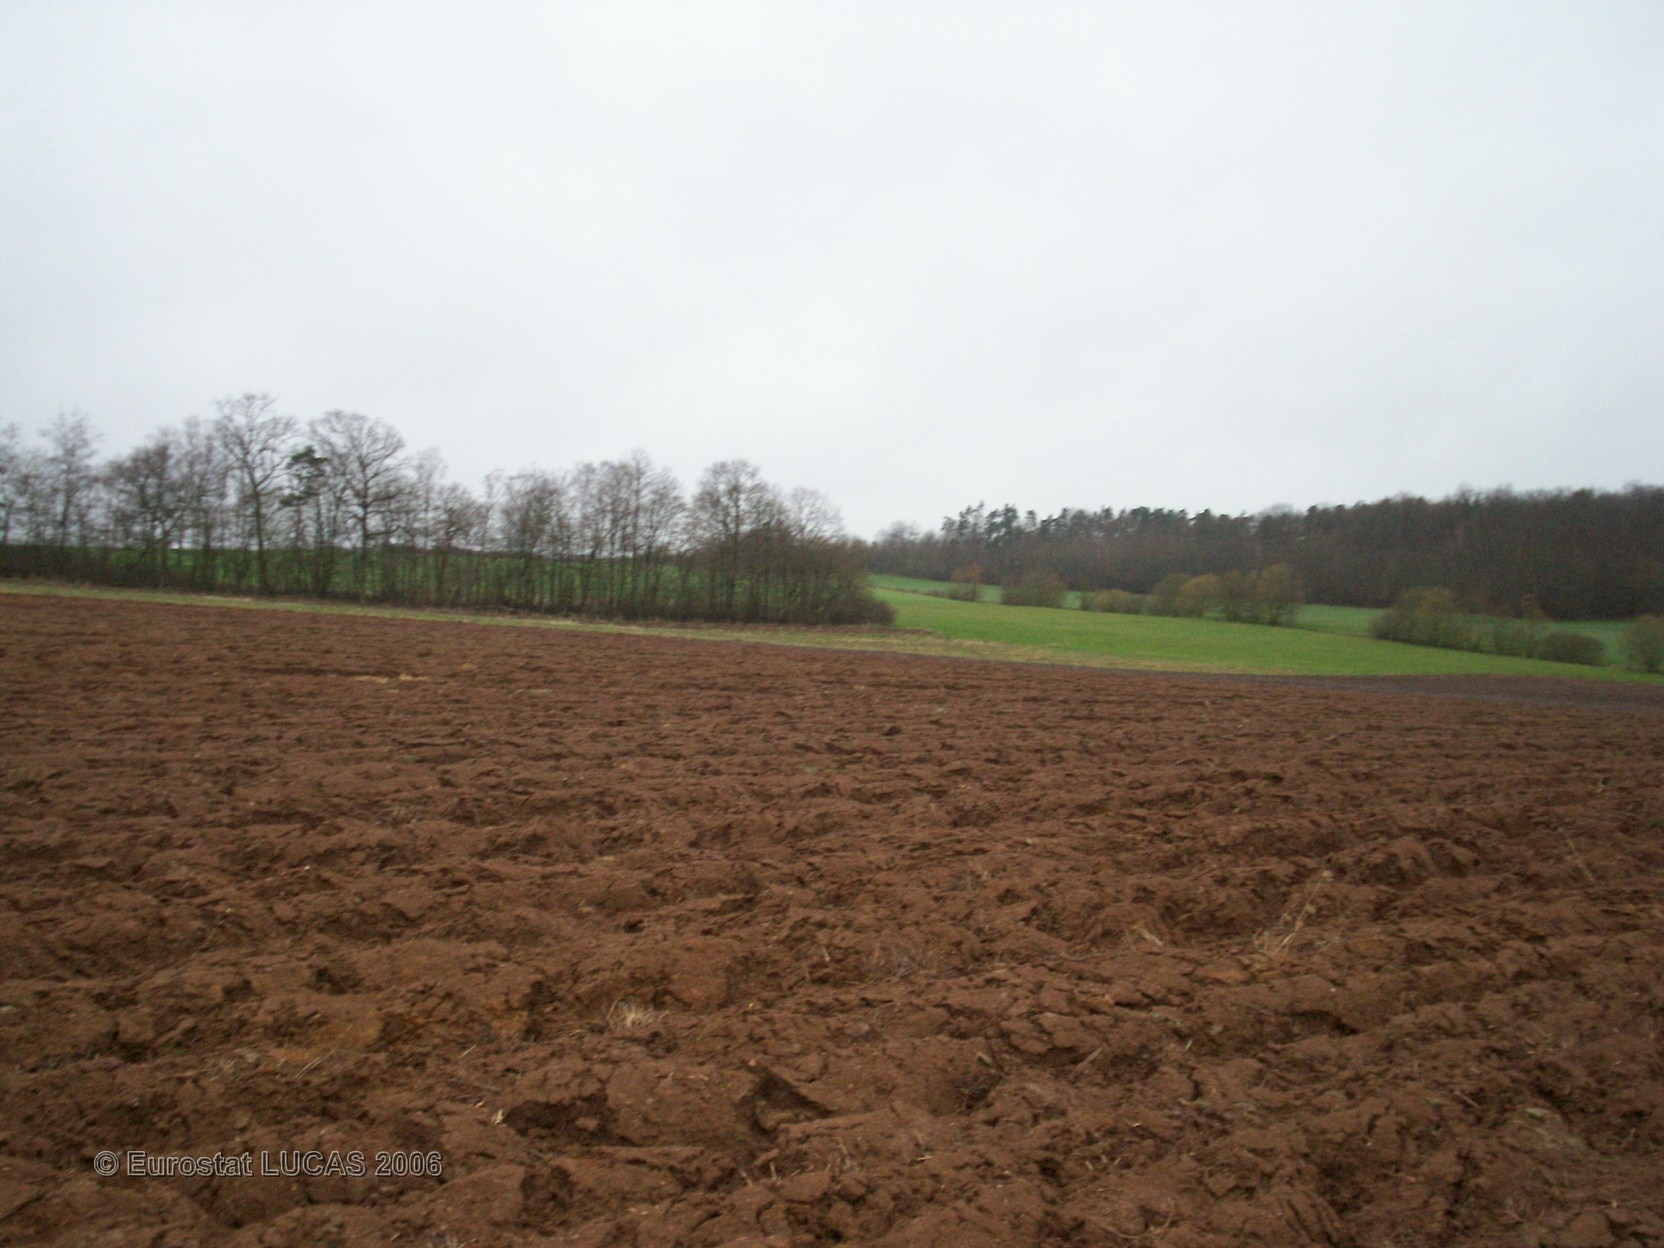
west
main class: Cropland
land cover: Maize
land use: Agriculture (excluding fallow land and kitchen gardens)
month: May
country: FR
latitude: 48.5902
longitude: 6.7602
